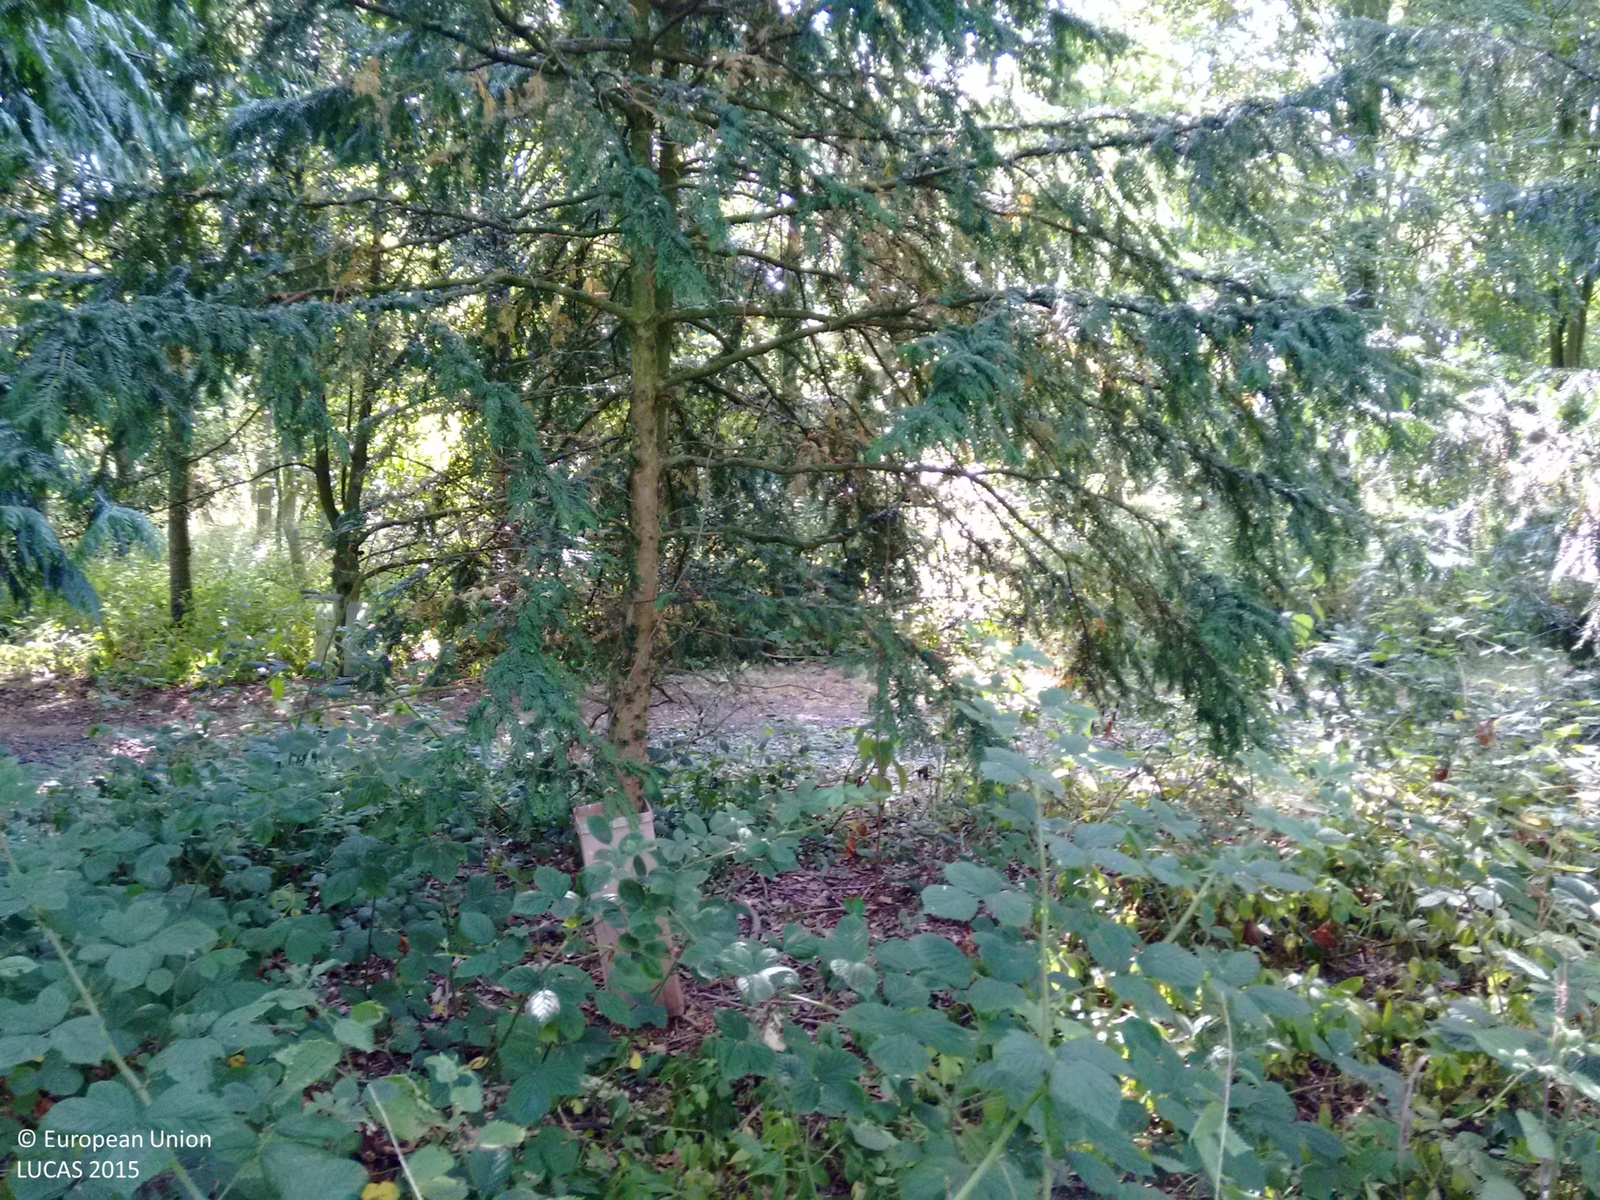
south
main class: Woodland
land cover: Broadleaved woodland
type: mesophytic deciduous forest
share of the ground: > 75 %
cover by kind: broadleaved forest trees 80 %, shrubs 20 %
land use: Forestry
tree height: > 5 m
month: August
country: GB
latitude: 52.1664
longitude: -0.8764
